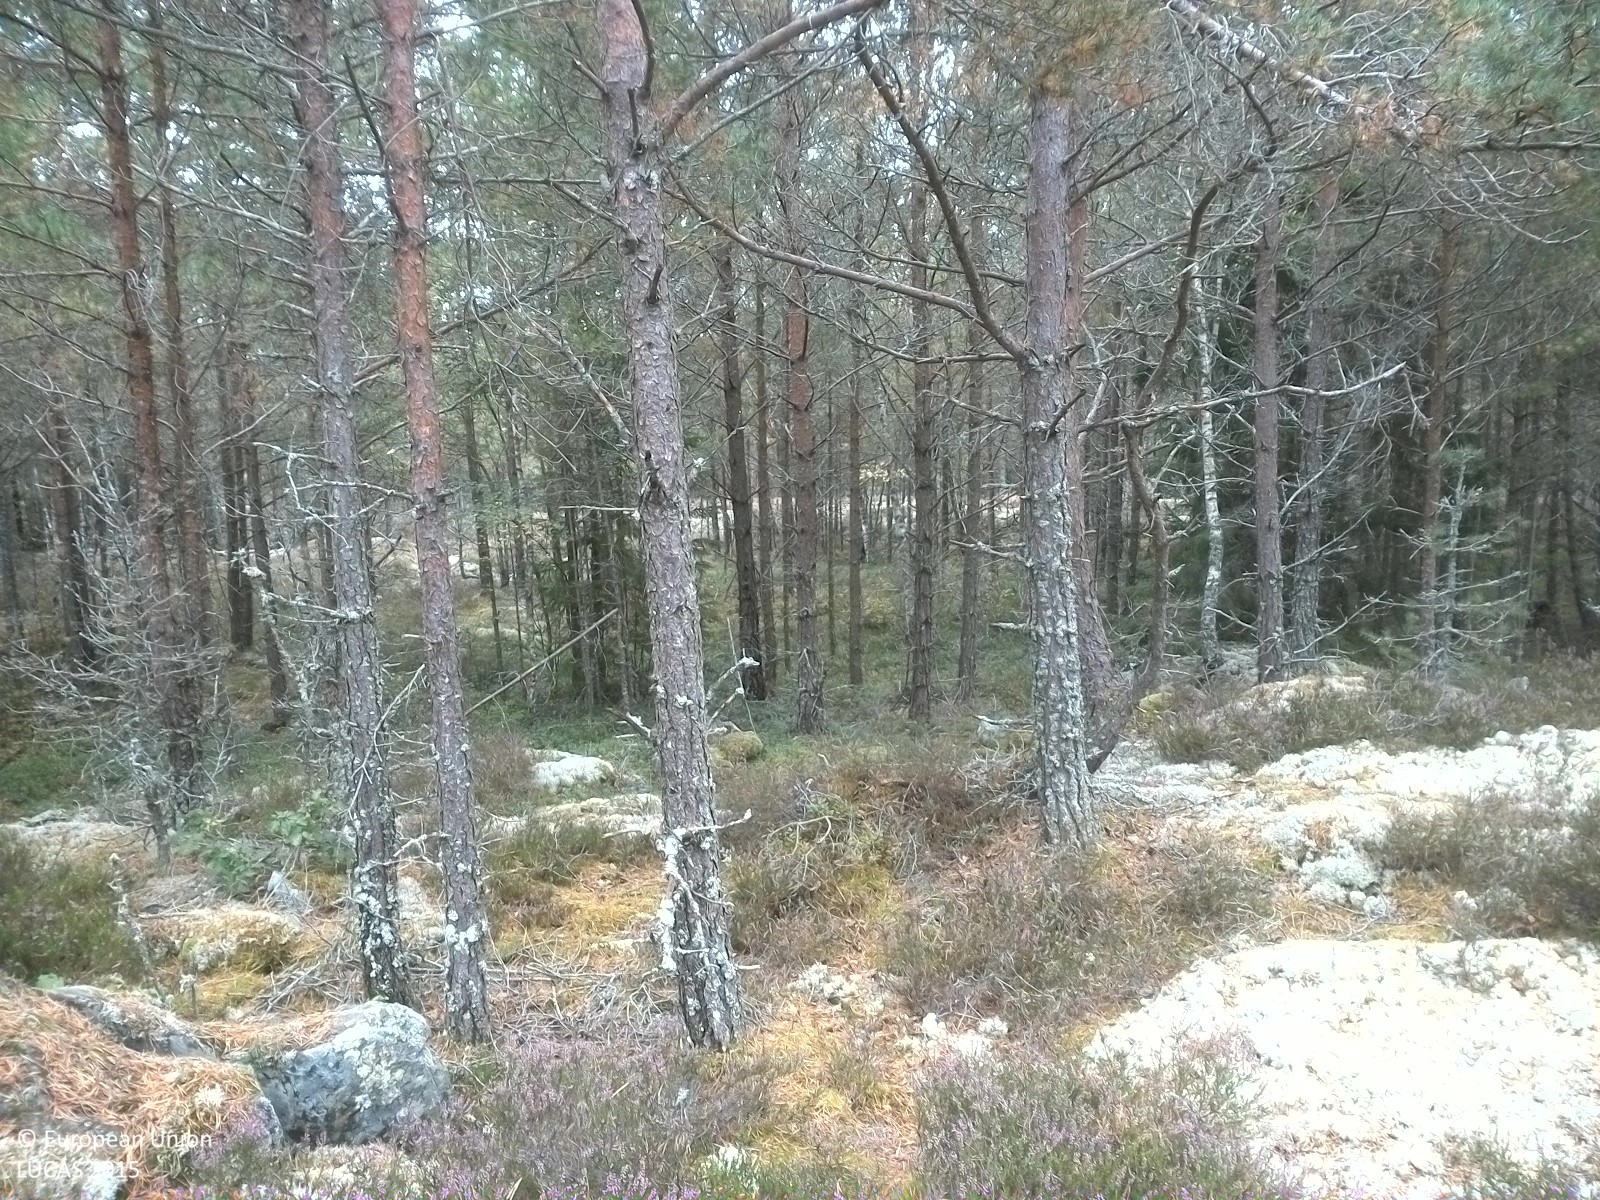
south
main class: Shrubland
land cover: Shrubland with sparse tree cover
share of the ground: > 75 %
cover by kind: shrubs 90 %, coniferous forest trees 5 %, lichens and mosses 5 %
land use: Semi-natural and natural areas not in use
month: September
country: SE
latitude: 58.4678
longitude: 16.6999
